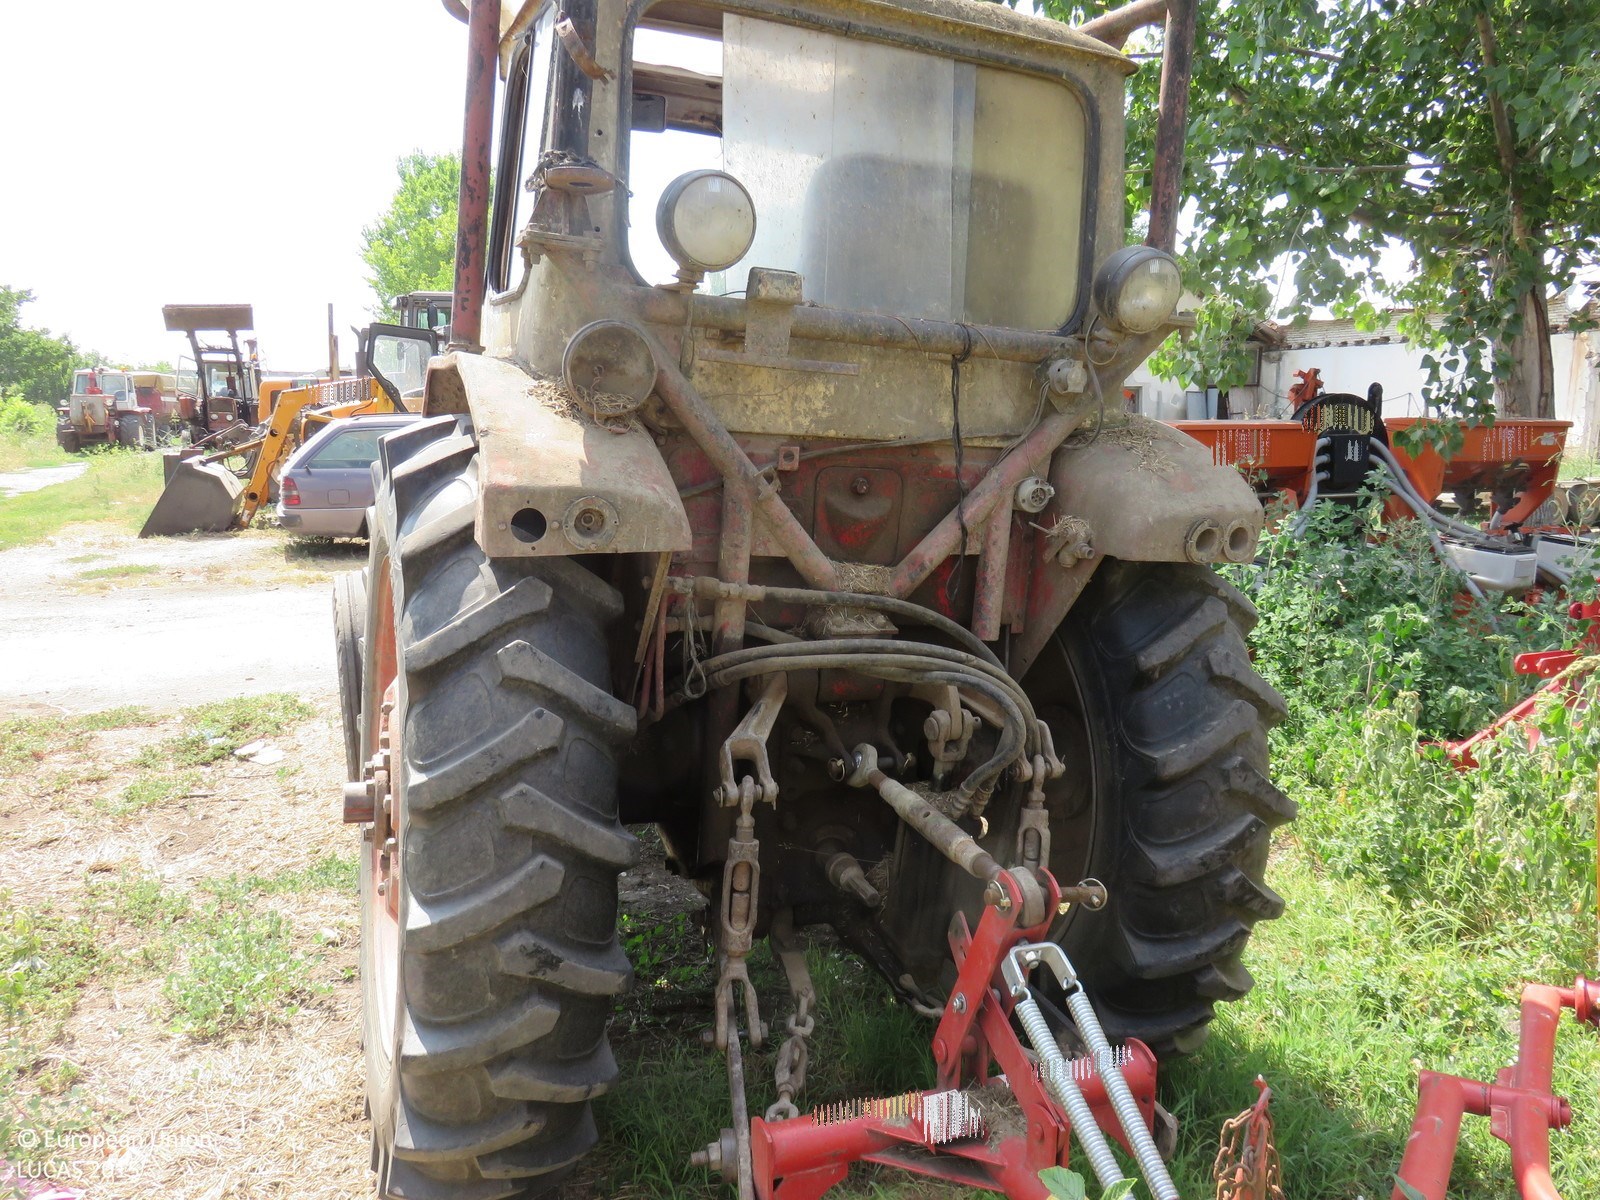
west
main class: Grassland
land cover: Spontaneously vegetated surfaces
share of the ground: > 75 %
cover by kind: herbaceous plants 90 %, unconsolidated bare surface 10 %
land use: Agriculture (excluding fallow land and kitchen gardens)
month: July
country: BG
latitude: 43.4207
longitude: 25.1040
